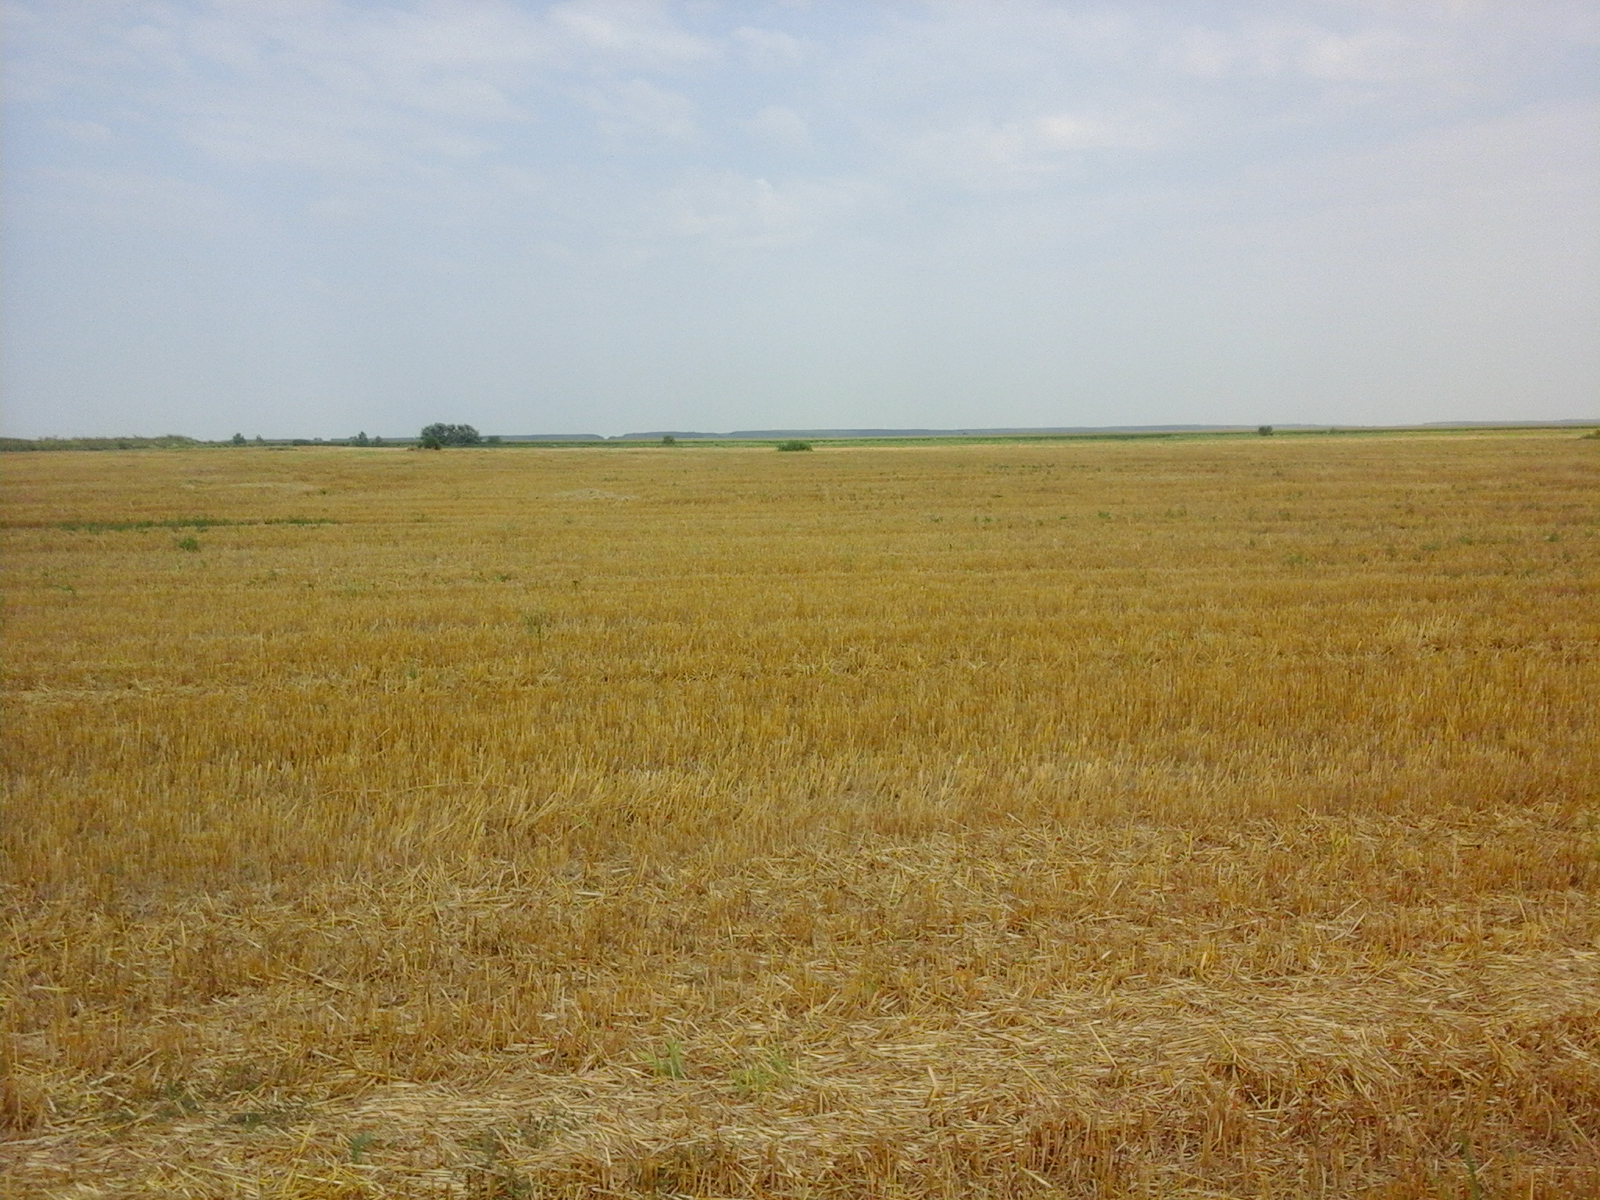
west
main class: Cropland
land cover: Common wheat
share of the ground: > 75 %
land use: Agriculture (excluding fallow land and kitchen gardens)
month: July
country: RO
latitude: 44.4763
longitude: 27.9970
